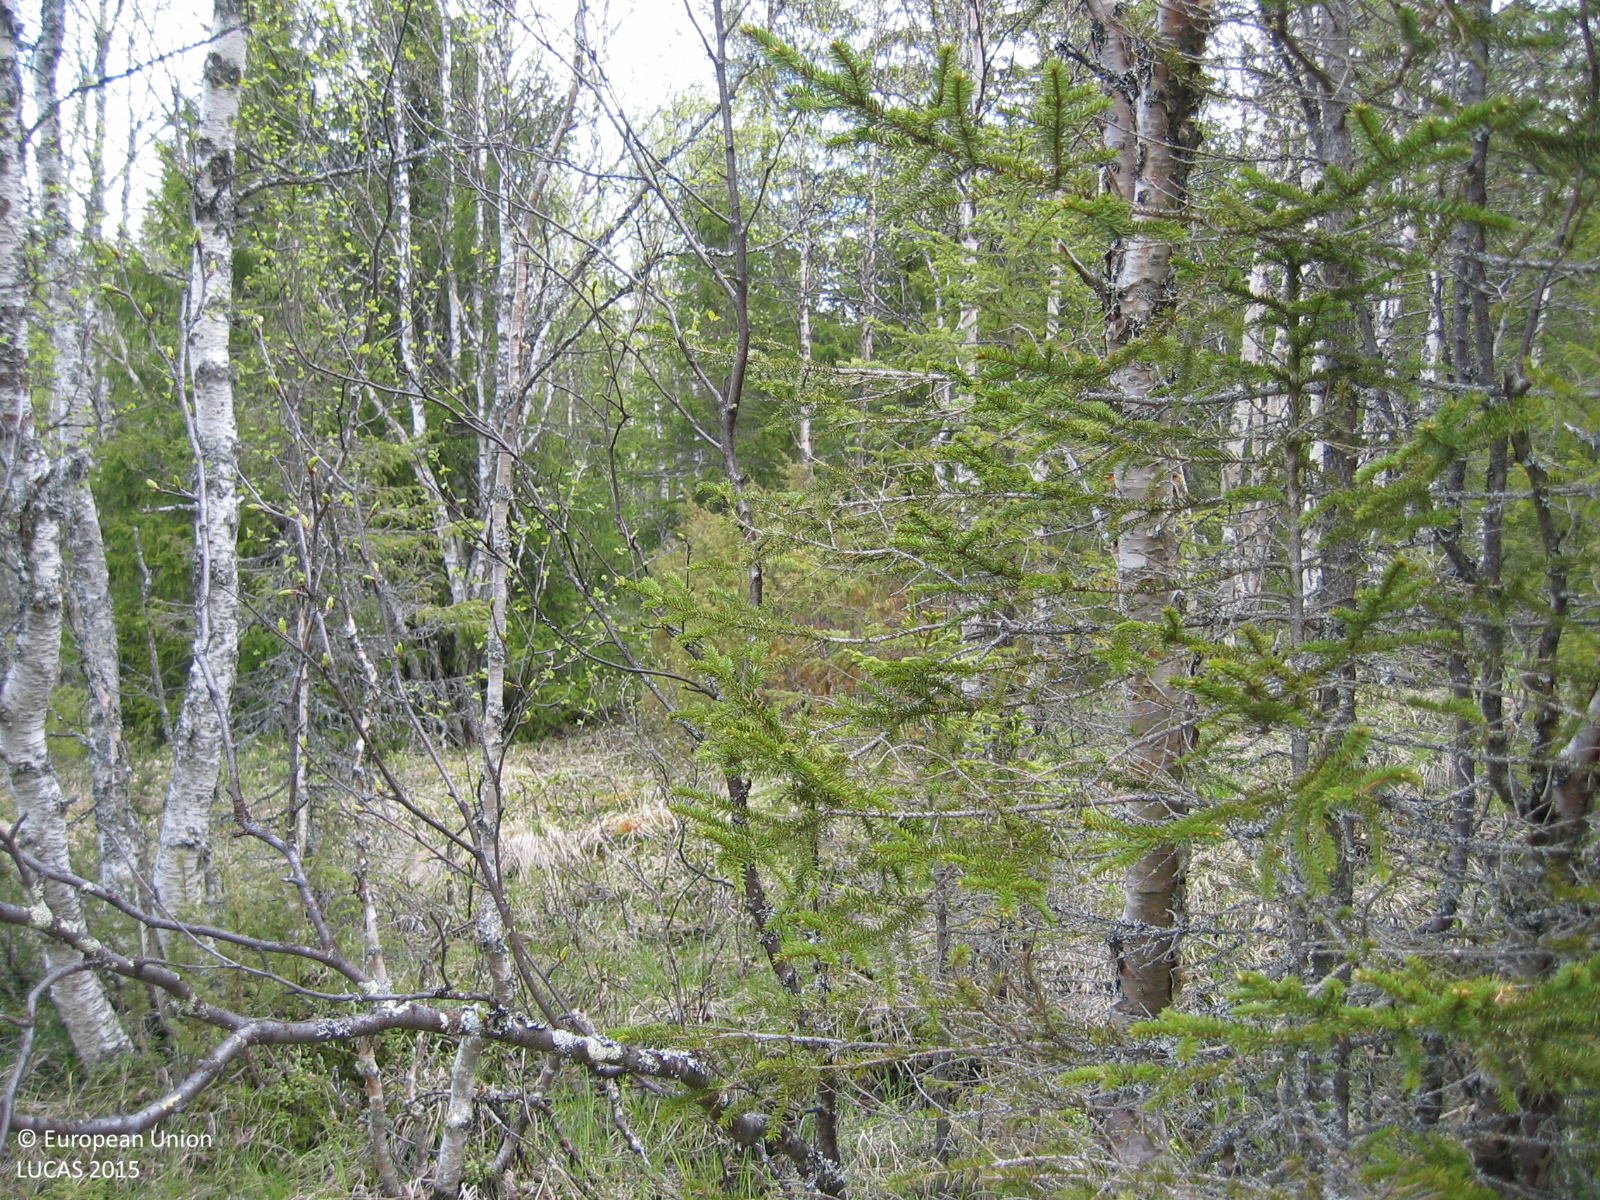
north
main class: Woodland
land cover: Spruce dominated mixed woodland
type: boreal forest
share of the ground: 50 - 75 %
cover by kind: coniferous forest trees 45 %, shrubs 20 %, herbaceous plants 20 %, broadleaved forest trees 15 %
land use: Forestry
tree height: > 5 m
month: June
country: SE
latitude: 63.5549
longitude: 13.9045
